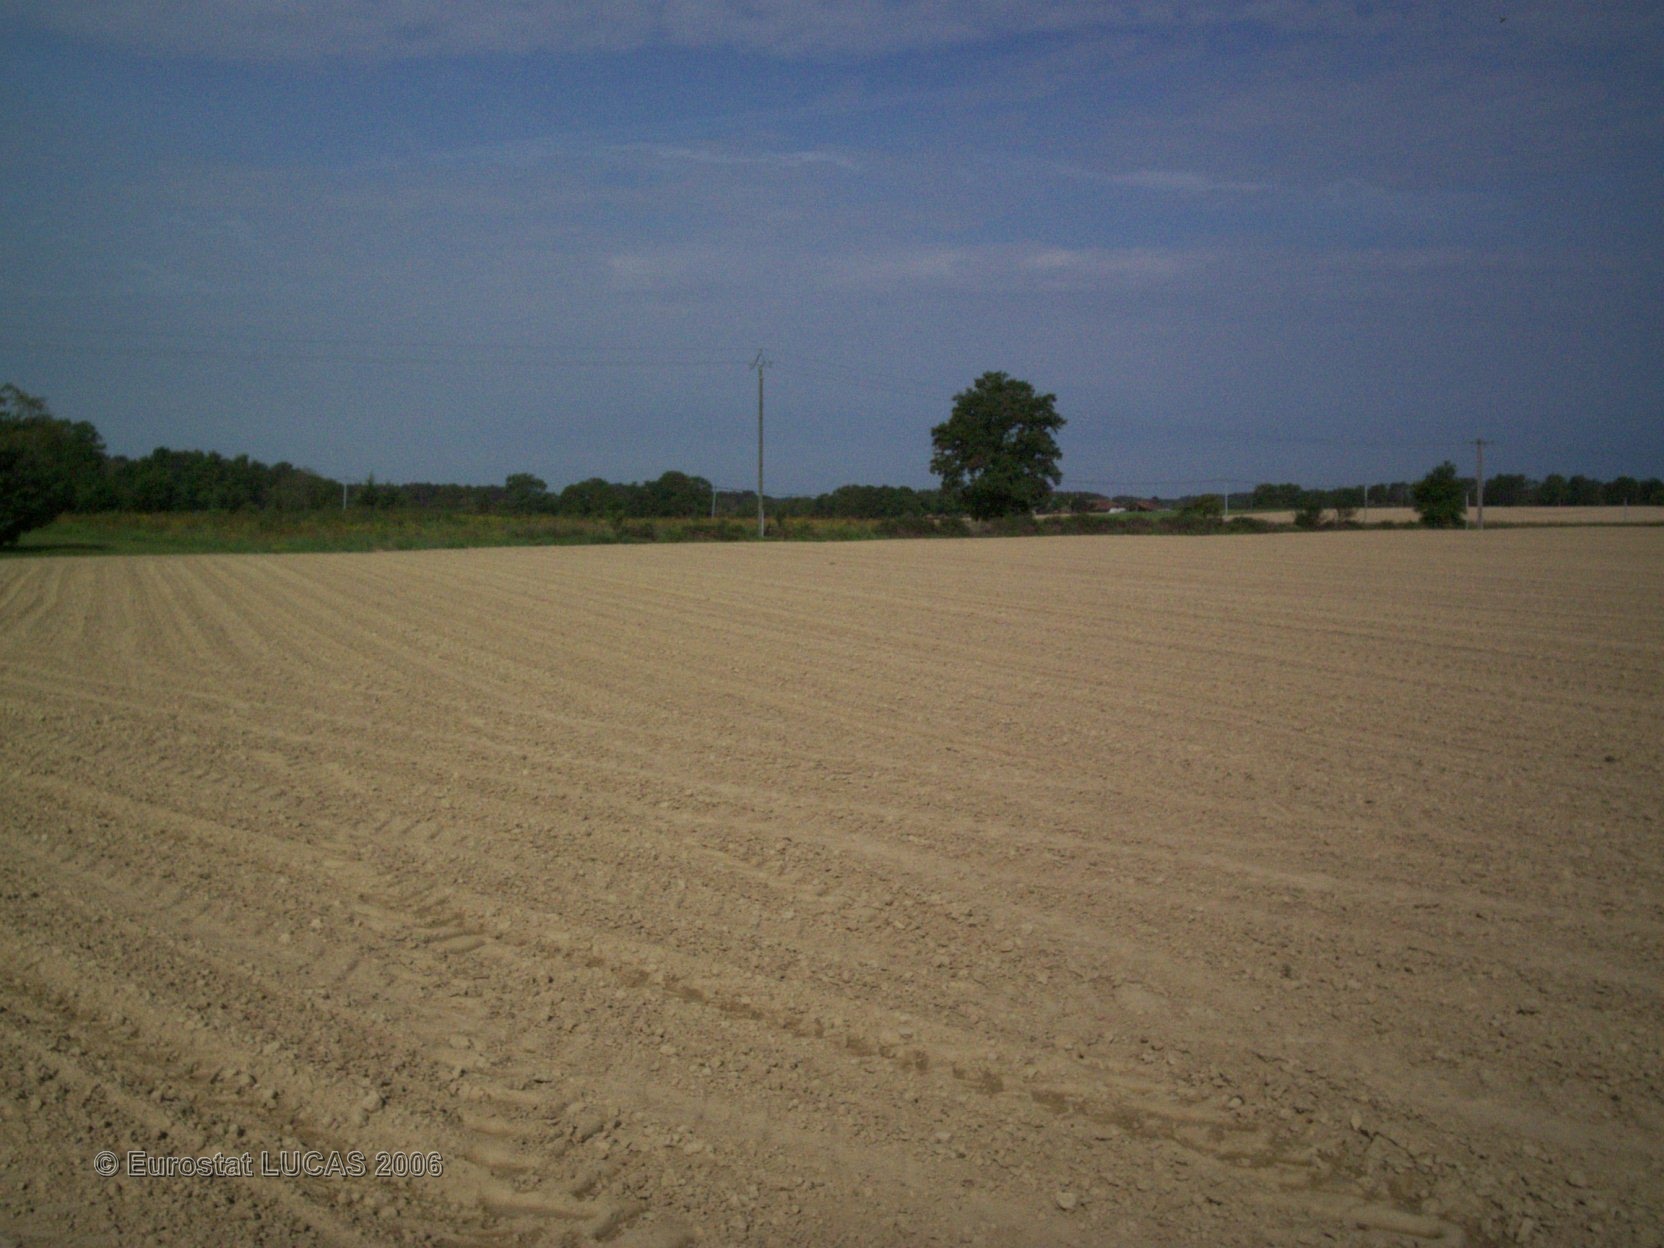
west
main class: Cropland
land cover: Maize
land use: Agriculture (excluding fallow land and kitchen gardens)
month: June
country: FR
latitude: 43.7380
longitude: -0.3775
